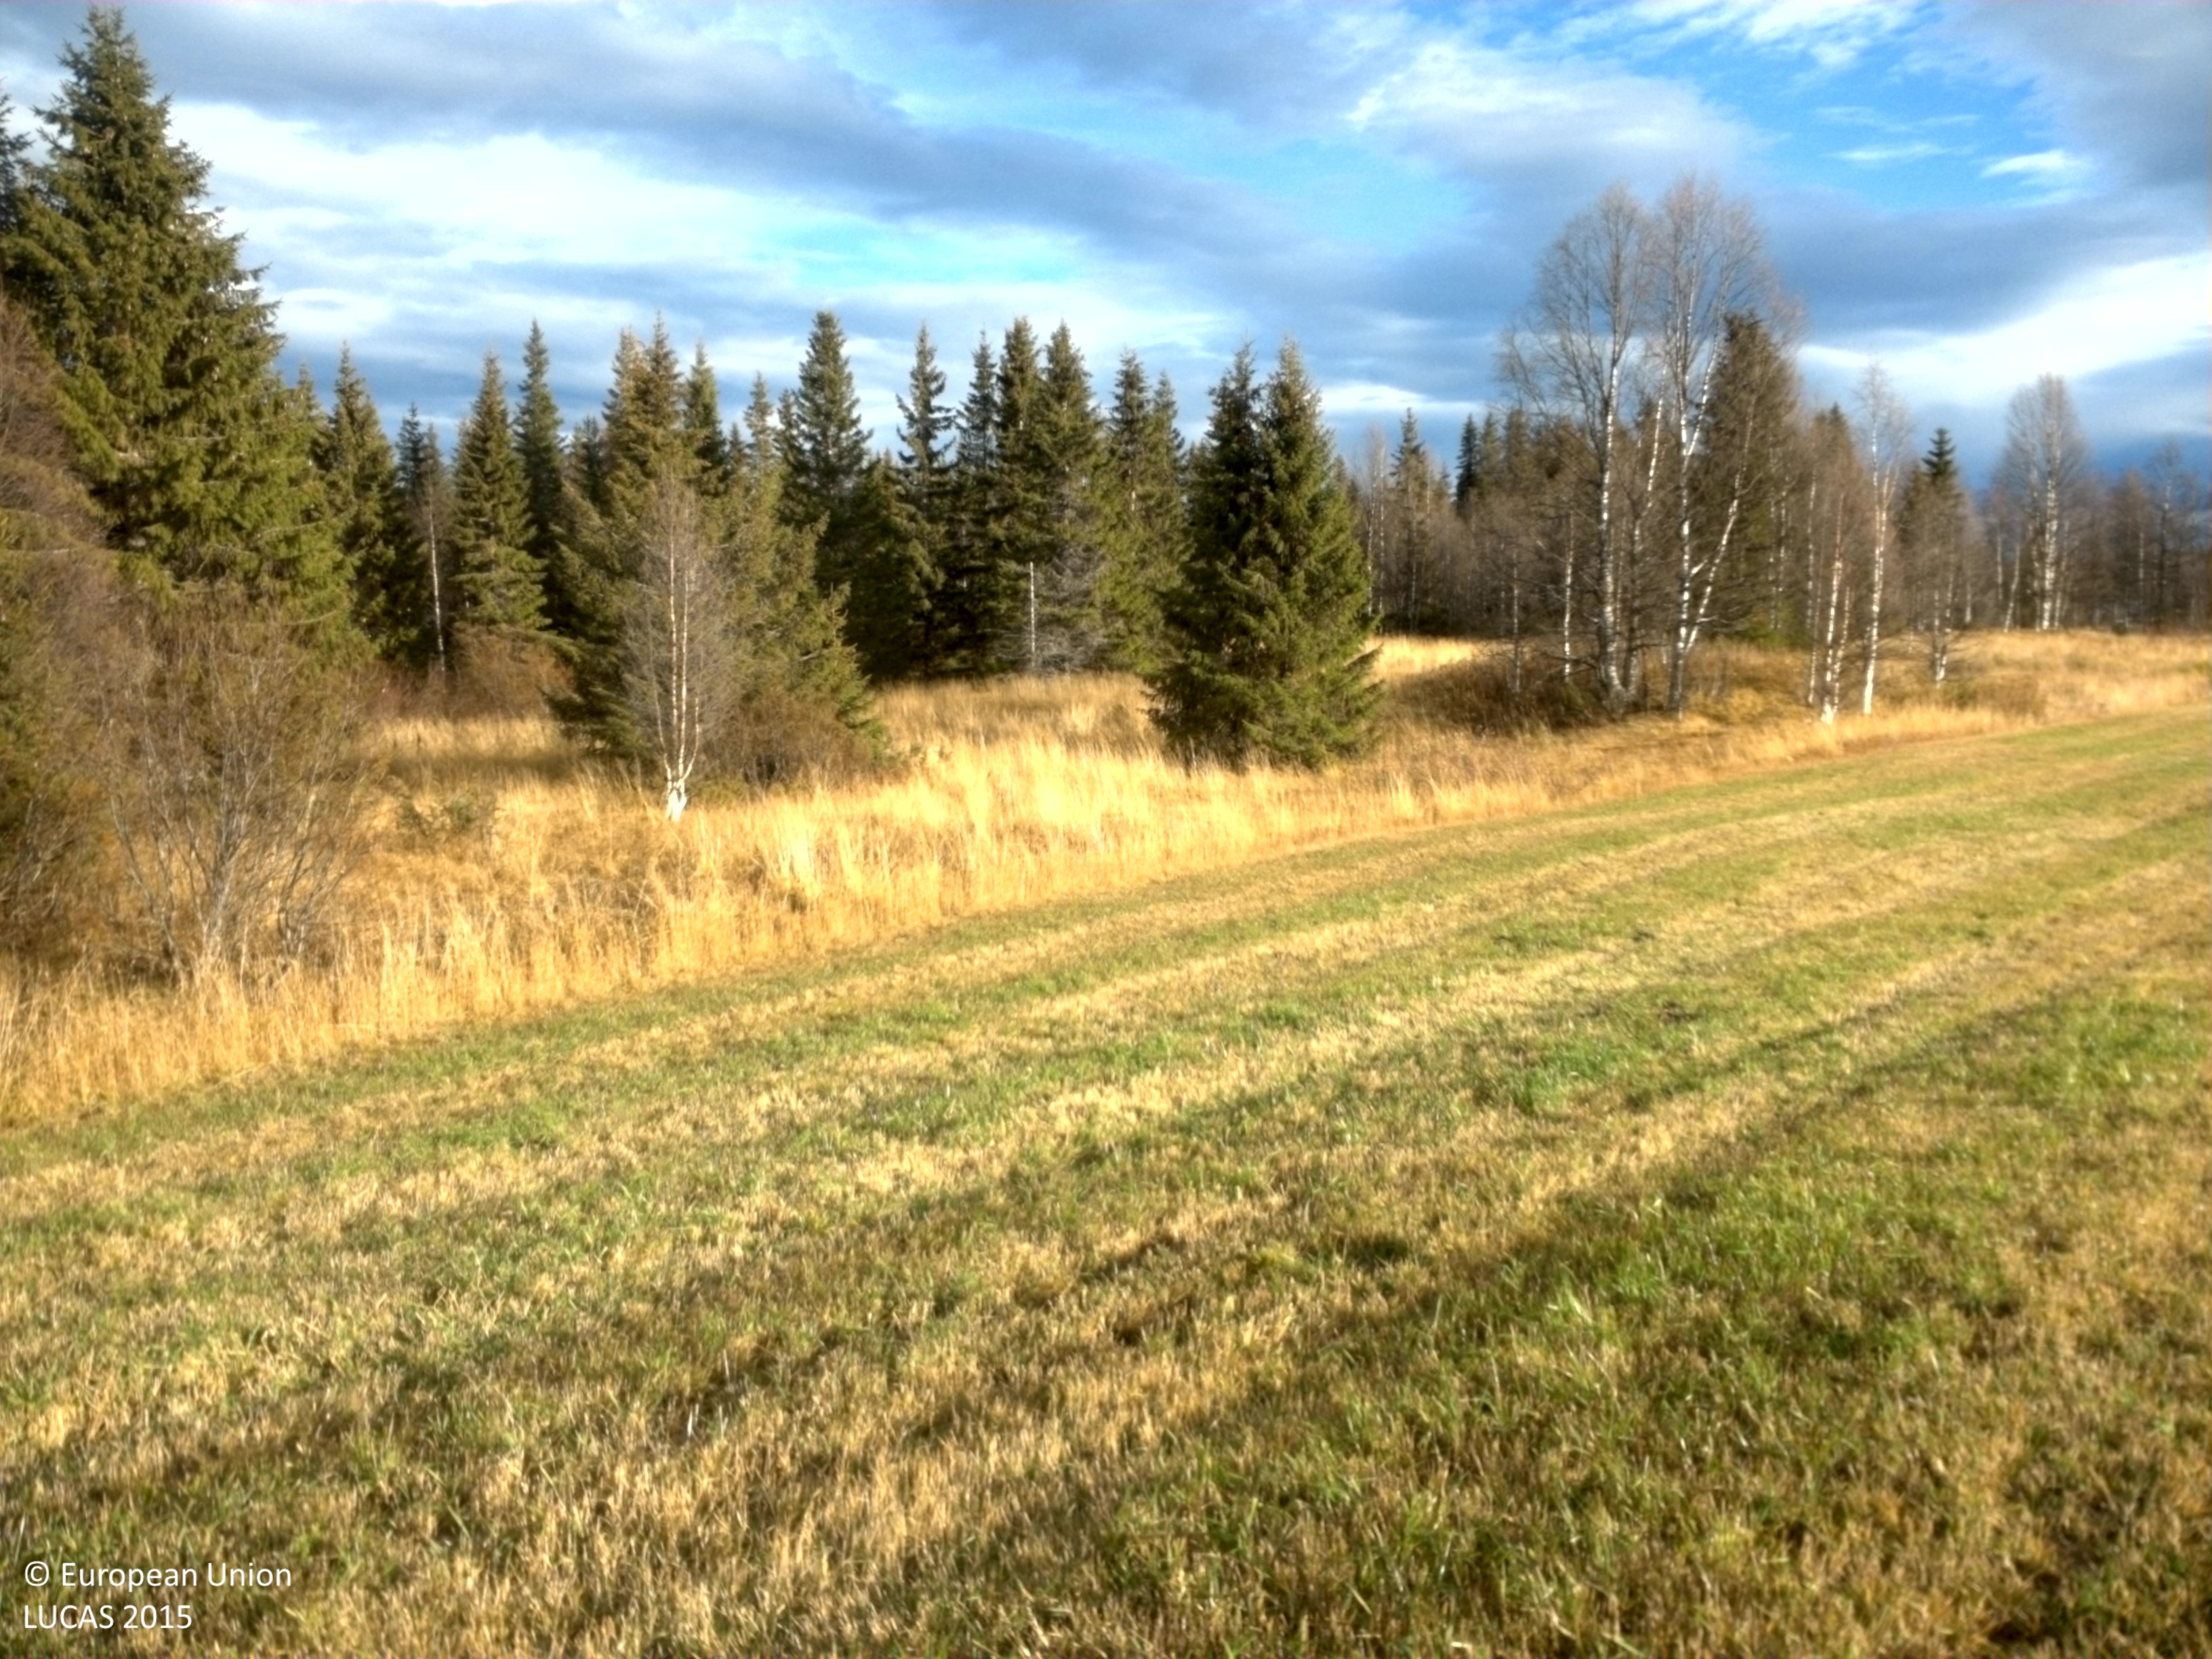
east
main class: Grassland
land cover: Grassland without tree/shrub cover
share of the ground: > 75 %
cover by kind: herbaceous plants 100 %
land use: Agriculture (excluding fallow land and kitchen gardens)
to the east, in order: Grassland without tree/shrub cover; Spruce dominated coniferous woodland; Grassland with sparse tree/shrub cover; Spruce dominated mixed woodland; Ditches and canals; Spruce dominated coniferous woodland
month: October
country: SE
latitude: 64.5405
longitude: 16.4102
